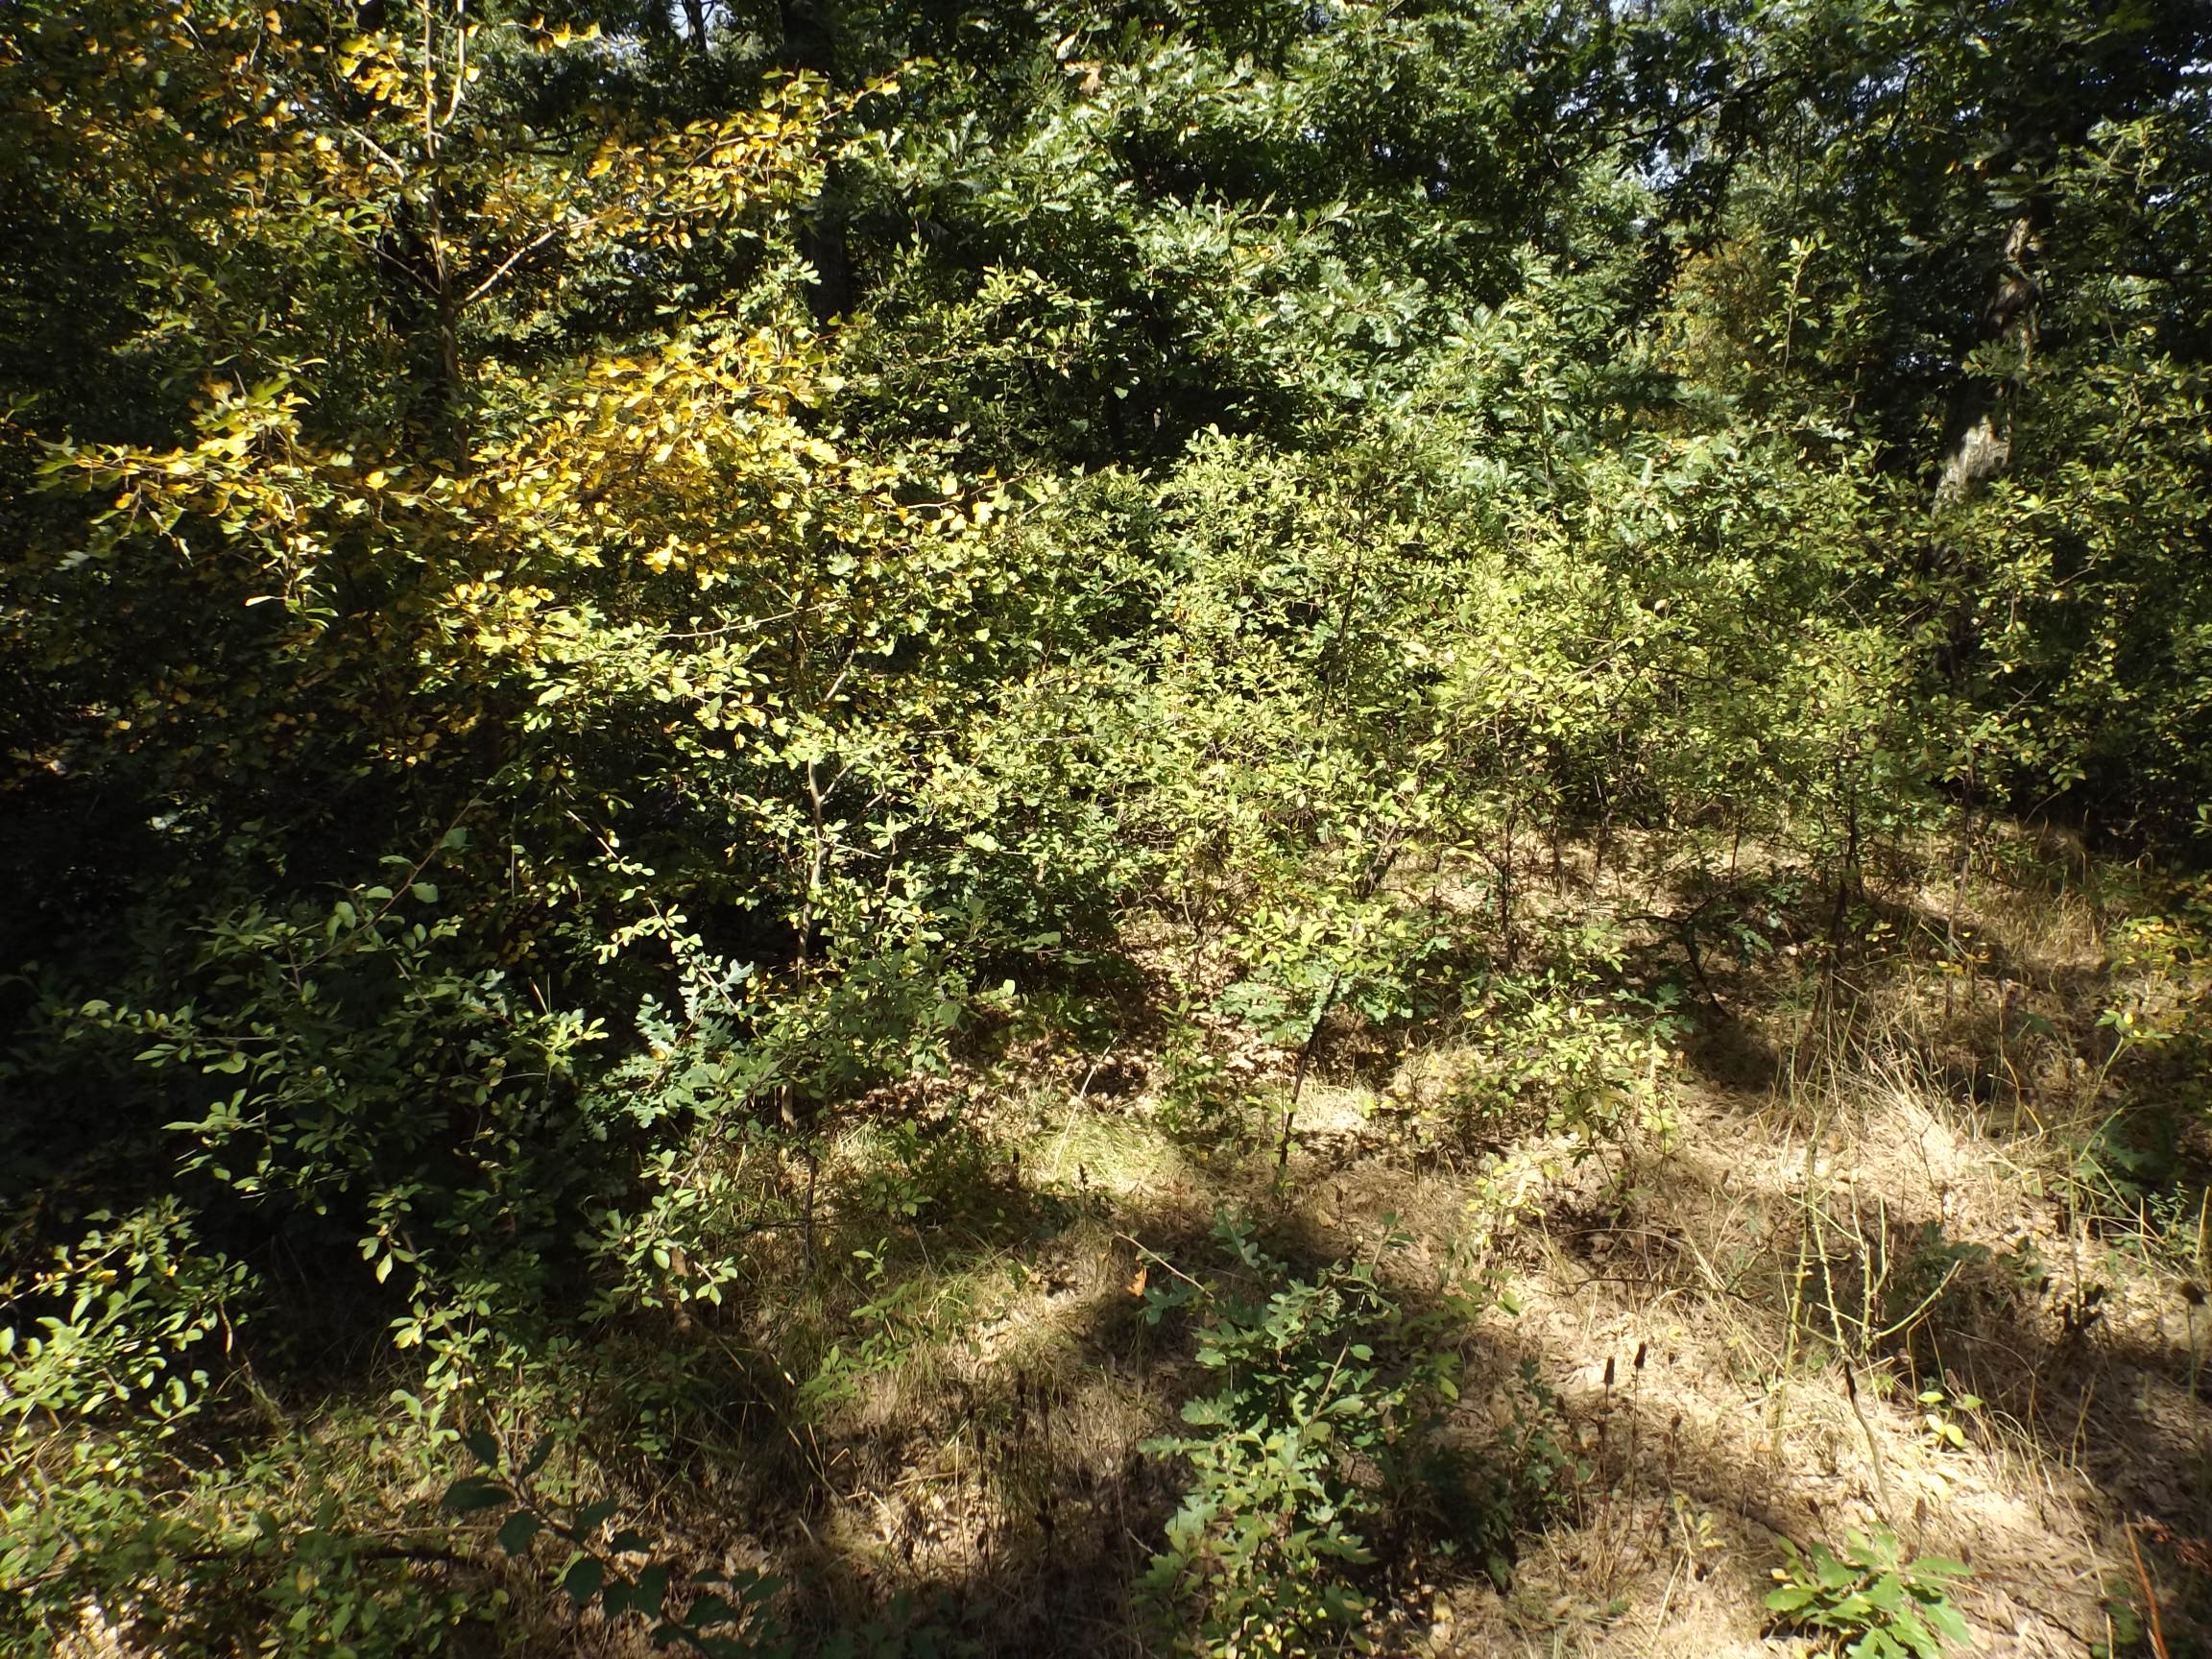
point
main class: Woodland
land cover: Broadleaved woodland
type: mesophytic deciduous forest
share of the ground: > 75 %
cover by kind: broadleaved forest trees 85 %, herbaceous plants 10 %, shrubs 5 %
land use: Forestry
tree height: > 5 m
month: September
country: BG
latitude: 43.4112
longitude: 27.6582
